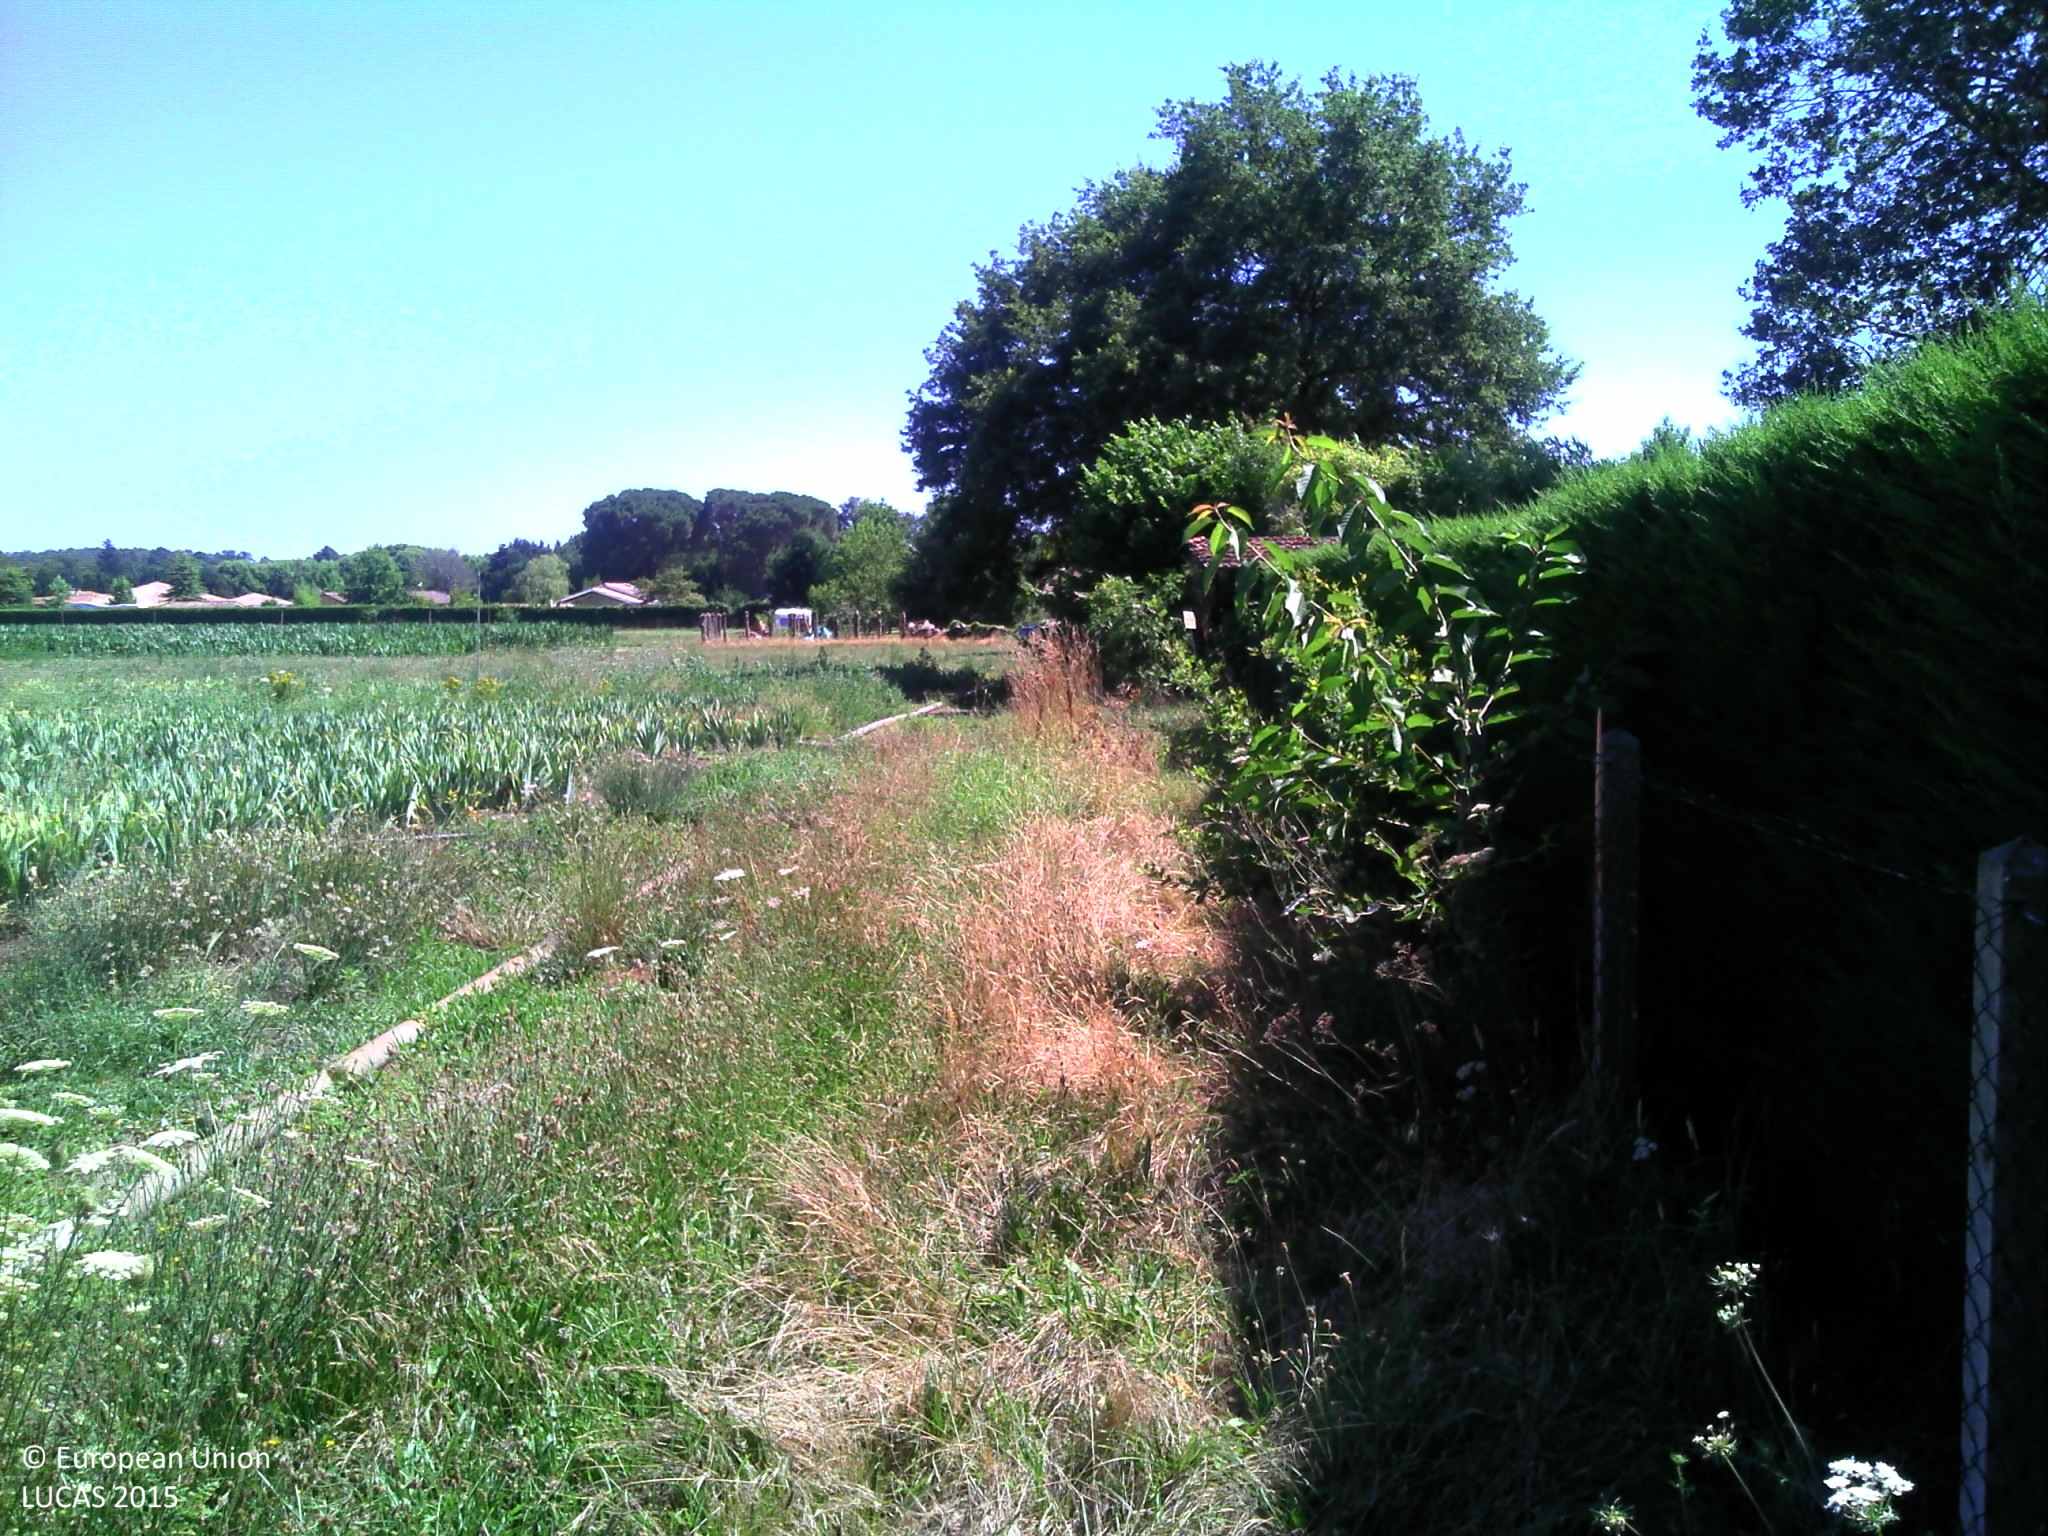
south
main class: Cropland
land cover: Floriculture and ornamental plants
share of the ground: > 75 %
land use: Agriculture (excluding fallow land and kitchen gardens)
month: July
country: FR
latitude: 44.0491
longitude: -0.5349
